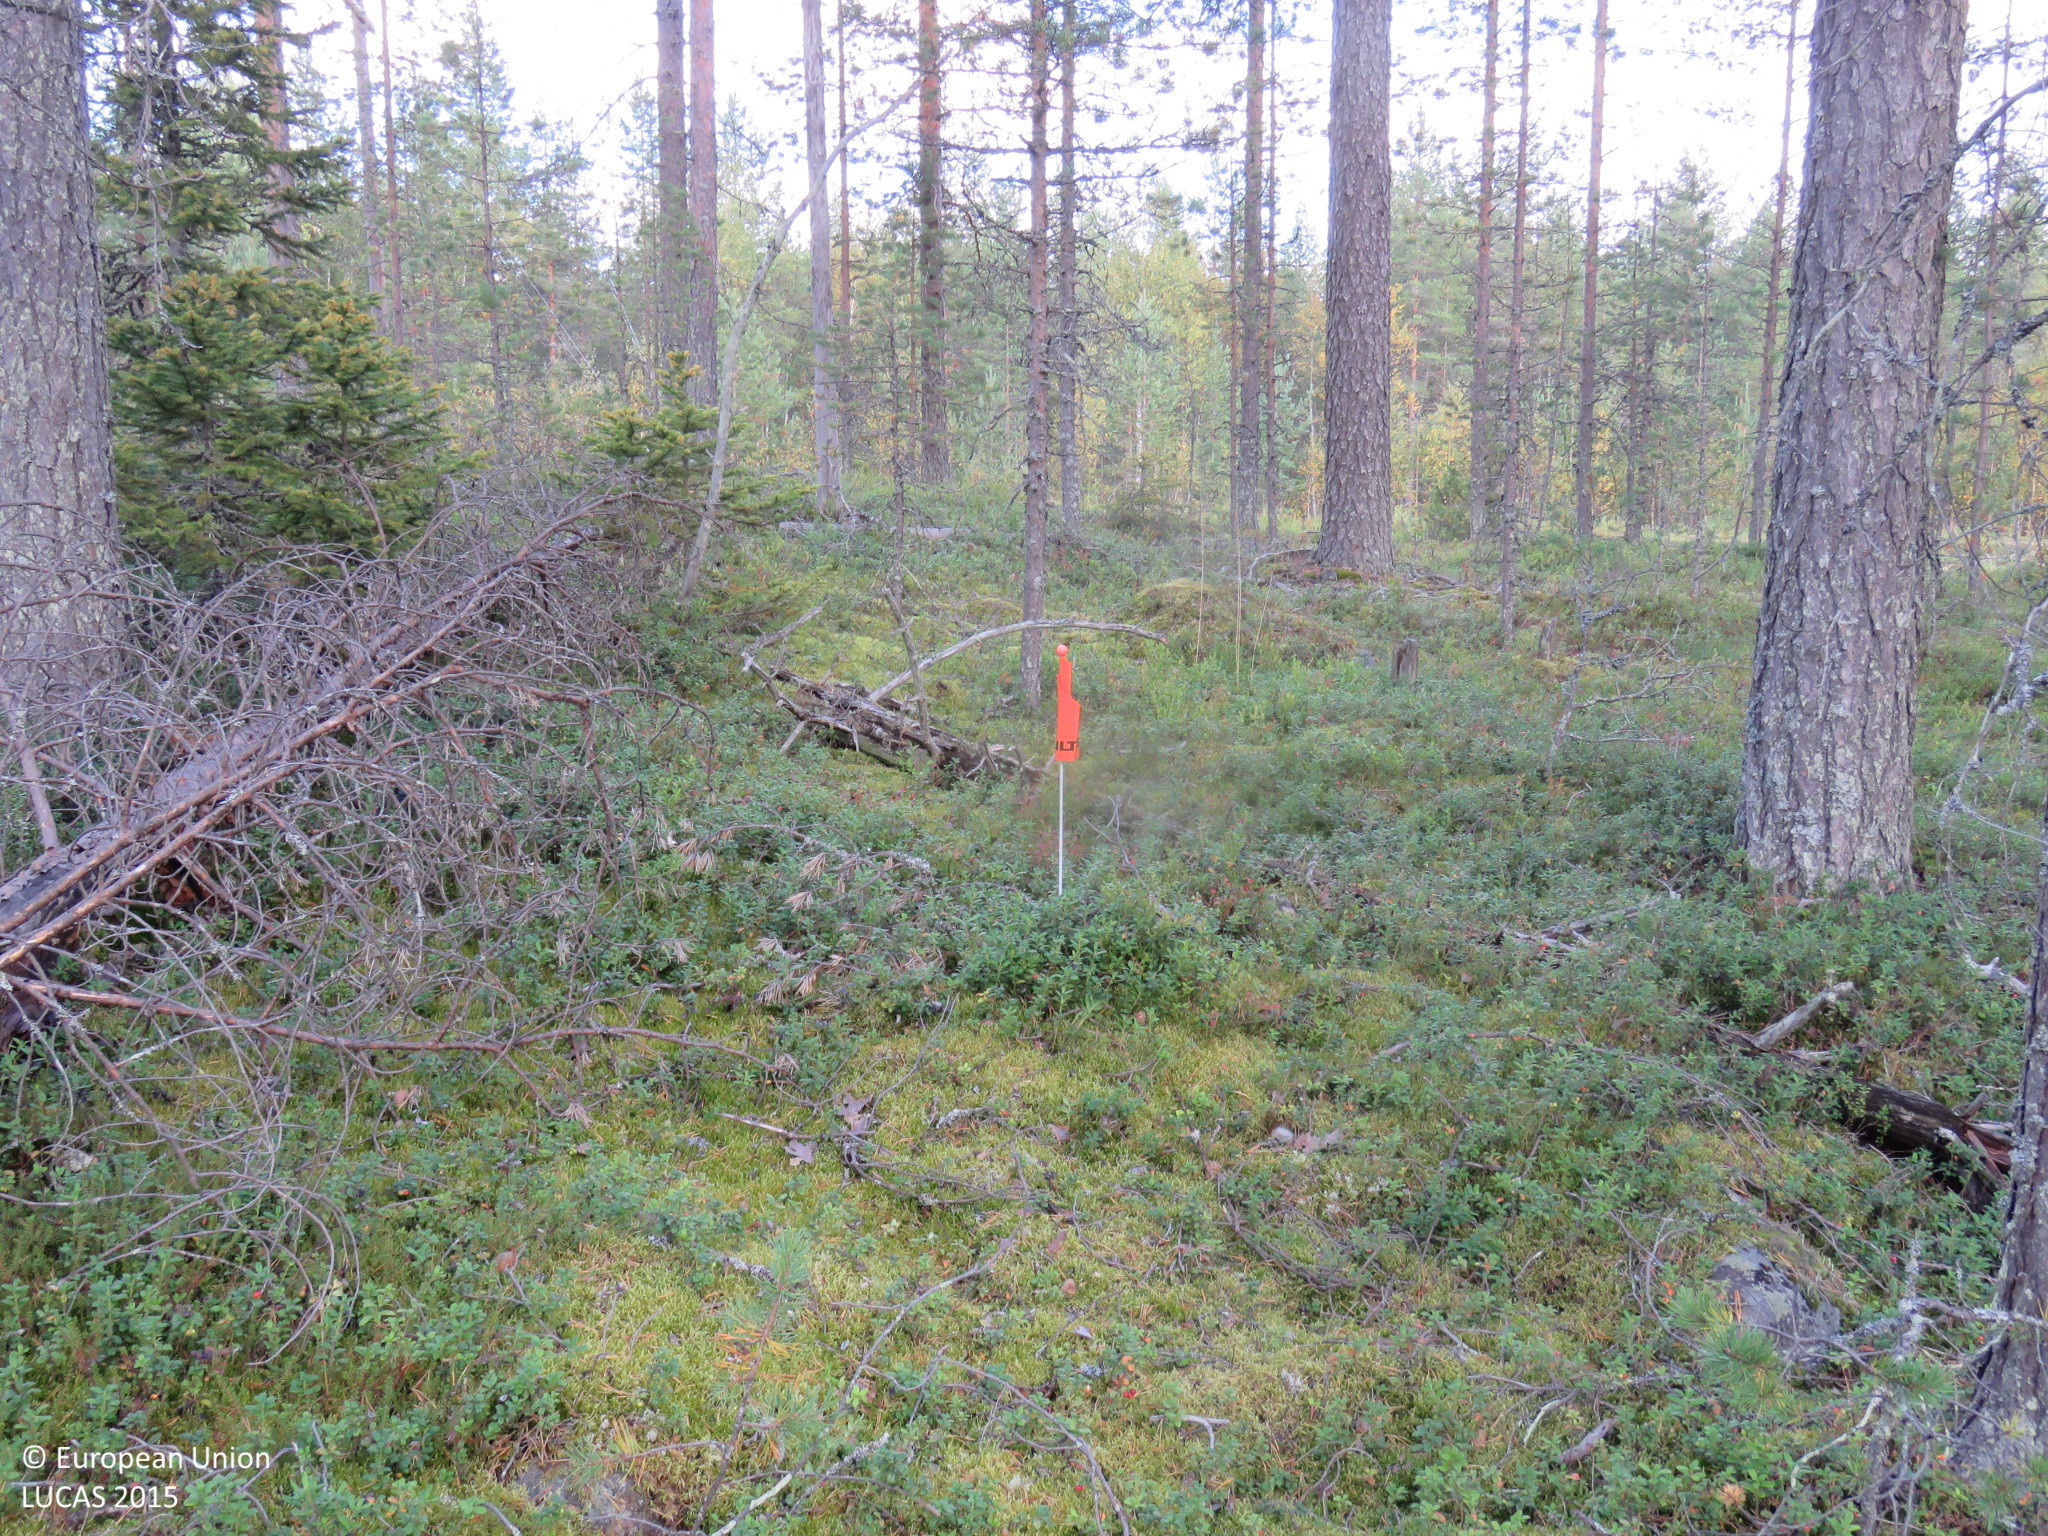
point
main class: Woodland
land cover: Pine dominated coniferous woodland
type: boreal forest
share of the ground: > 75 %
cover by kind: coniferous forest trees 80 %, shrubs 10 %, lichens and mosses 10 %
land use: Forestry
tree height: > 5 m
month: August
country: FI
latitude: 65.3511
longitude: 26.0586
